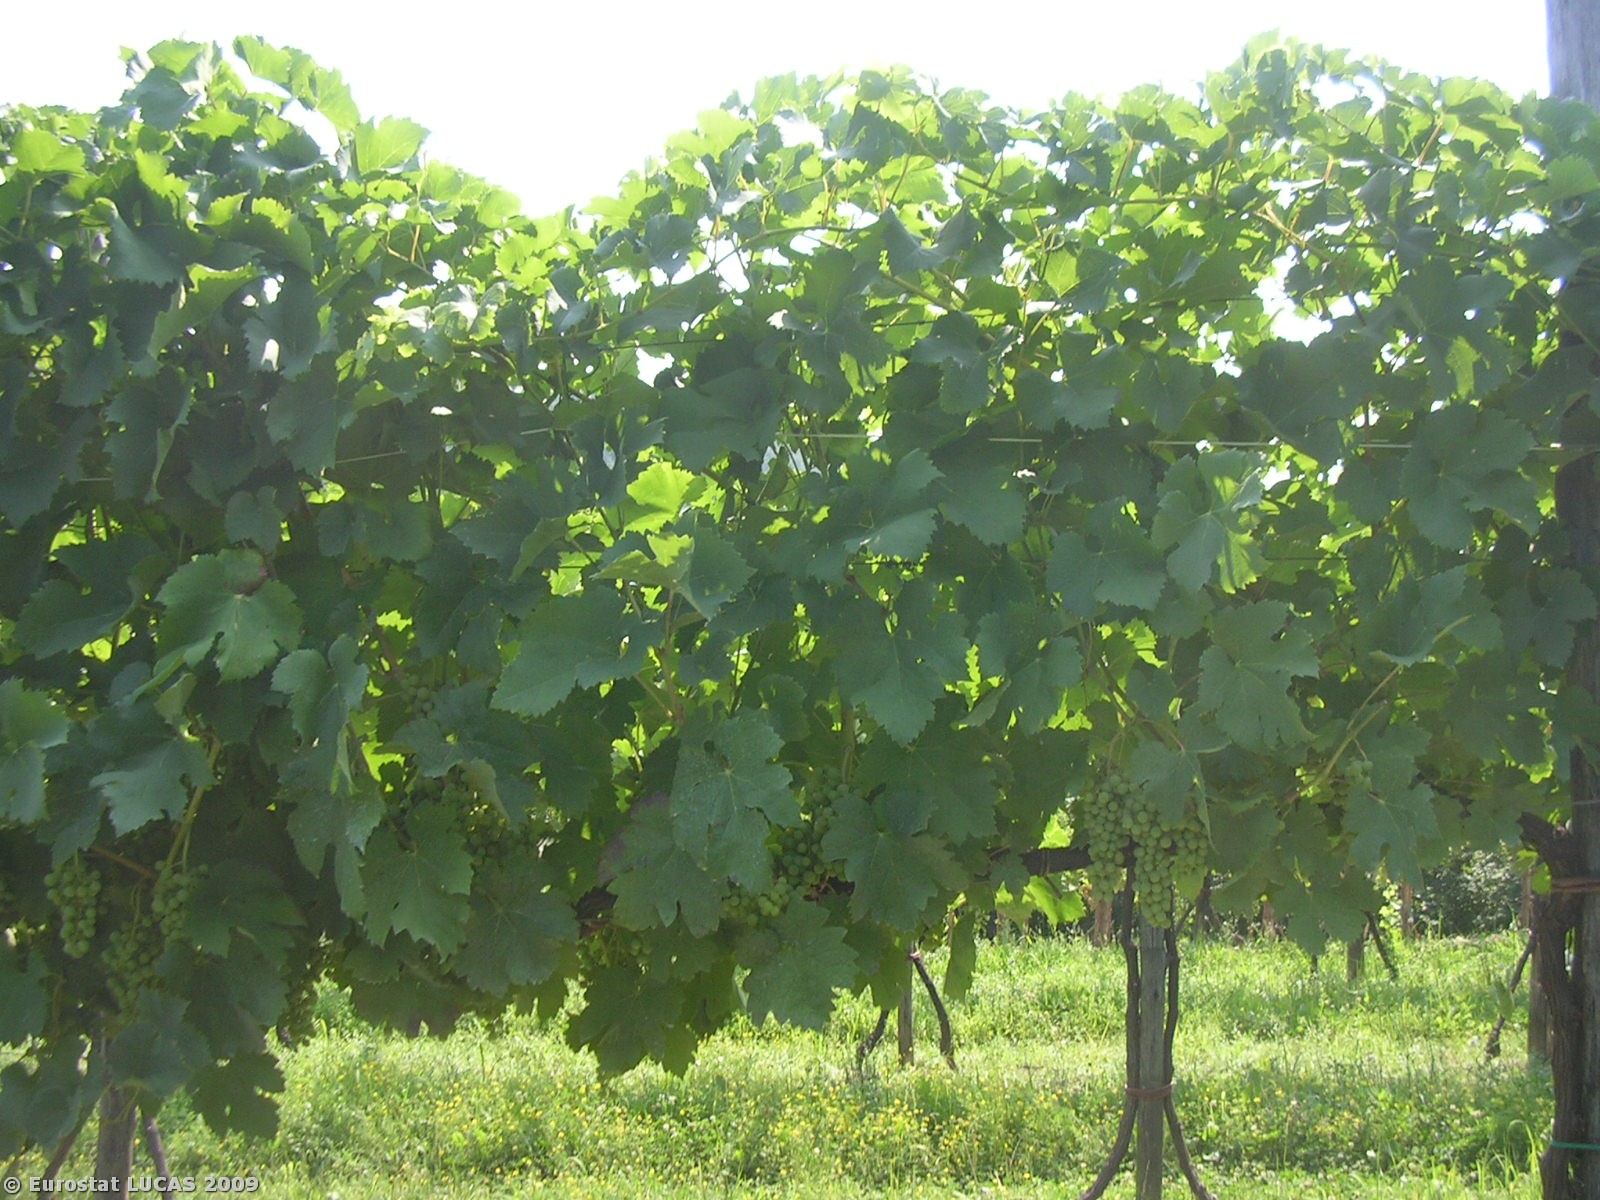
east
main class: Cropland
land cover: Vineyards
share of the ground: > 75 %
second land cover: Grassland with sparse tree/shrub cover
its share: 10 - 25 %
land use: Agriculture (excluding fallow land and kitchen gardens)
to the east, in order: Vineyards; Grassland with sparse tree/shrub cover; Other fresh vegetables; Tracks; Vineyards; Grassland with sparse tree/shrub cover; Tracks; Common wheat; Tracks; Abandoned hedges; Ditches and canals; Abandoned hedges; Grass margins; Common wheat; Ditches and canals; Grass margins
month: July
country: IT
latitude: 45.3462
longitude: 11.7201
